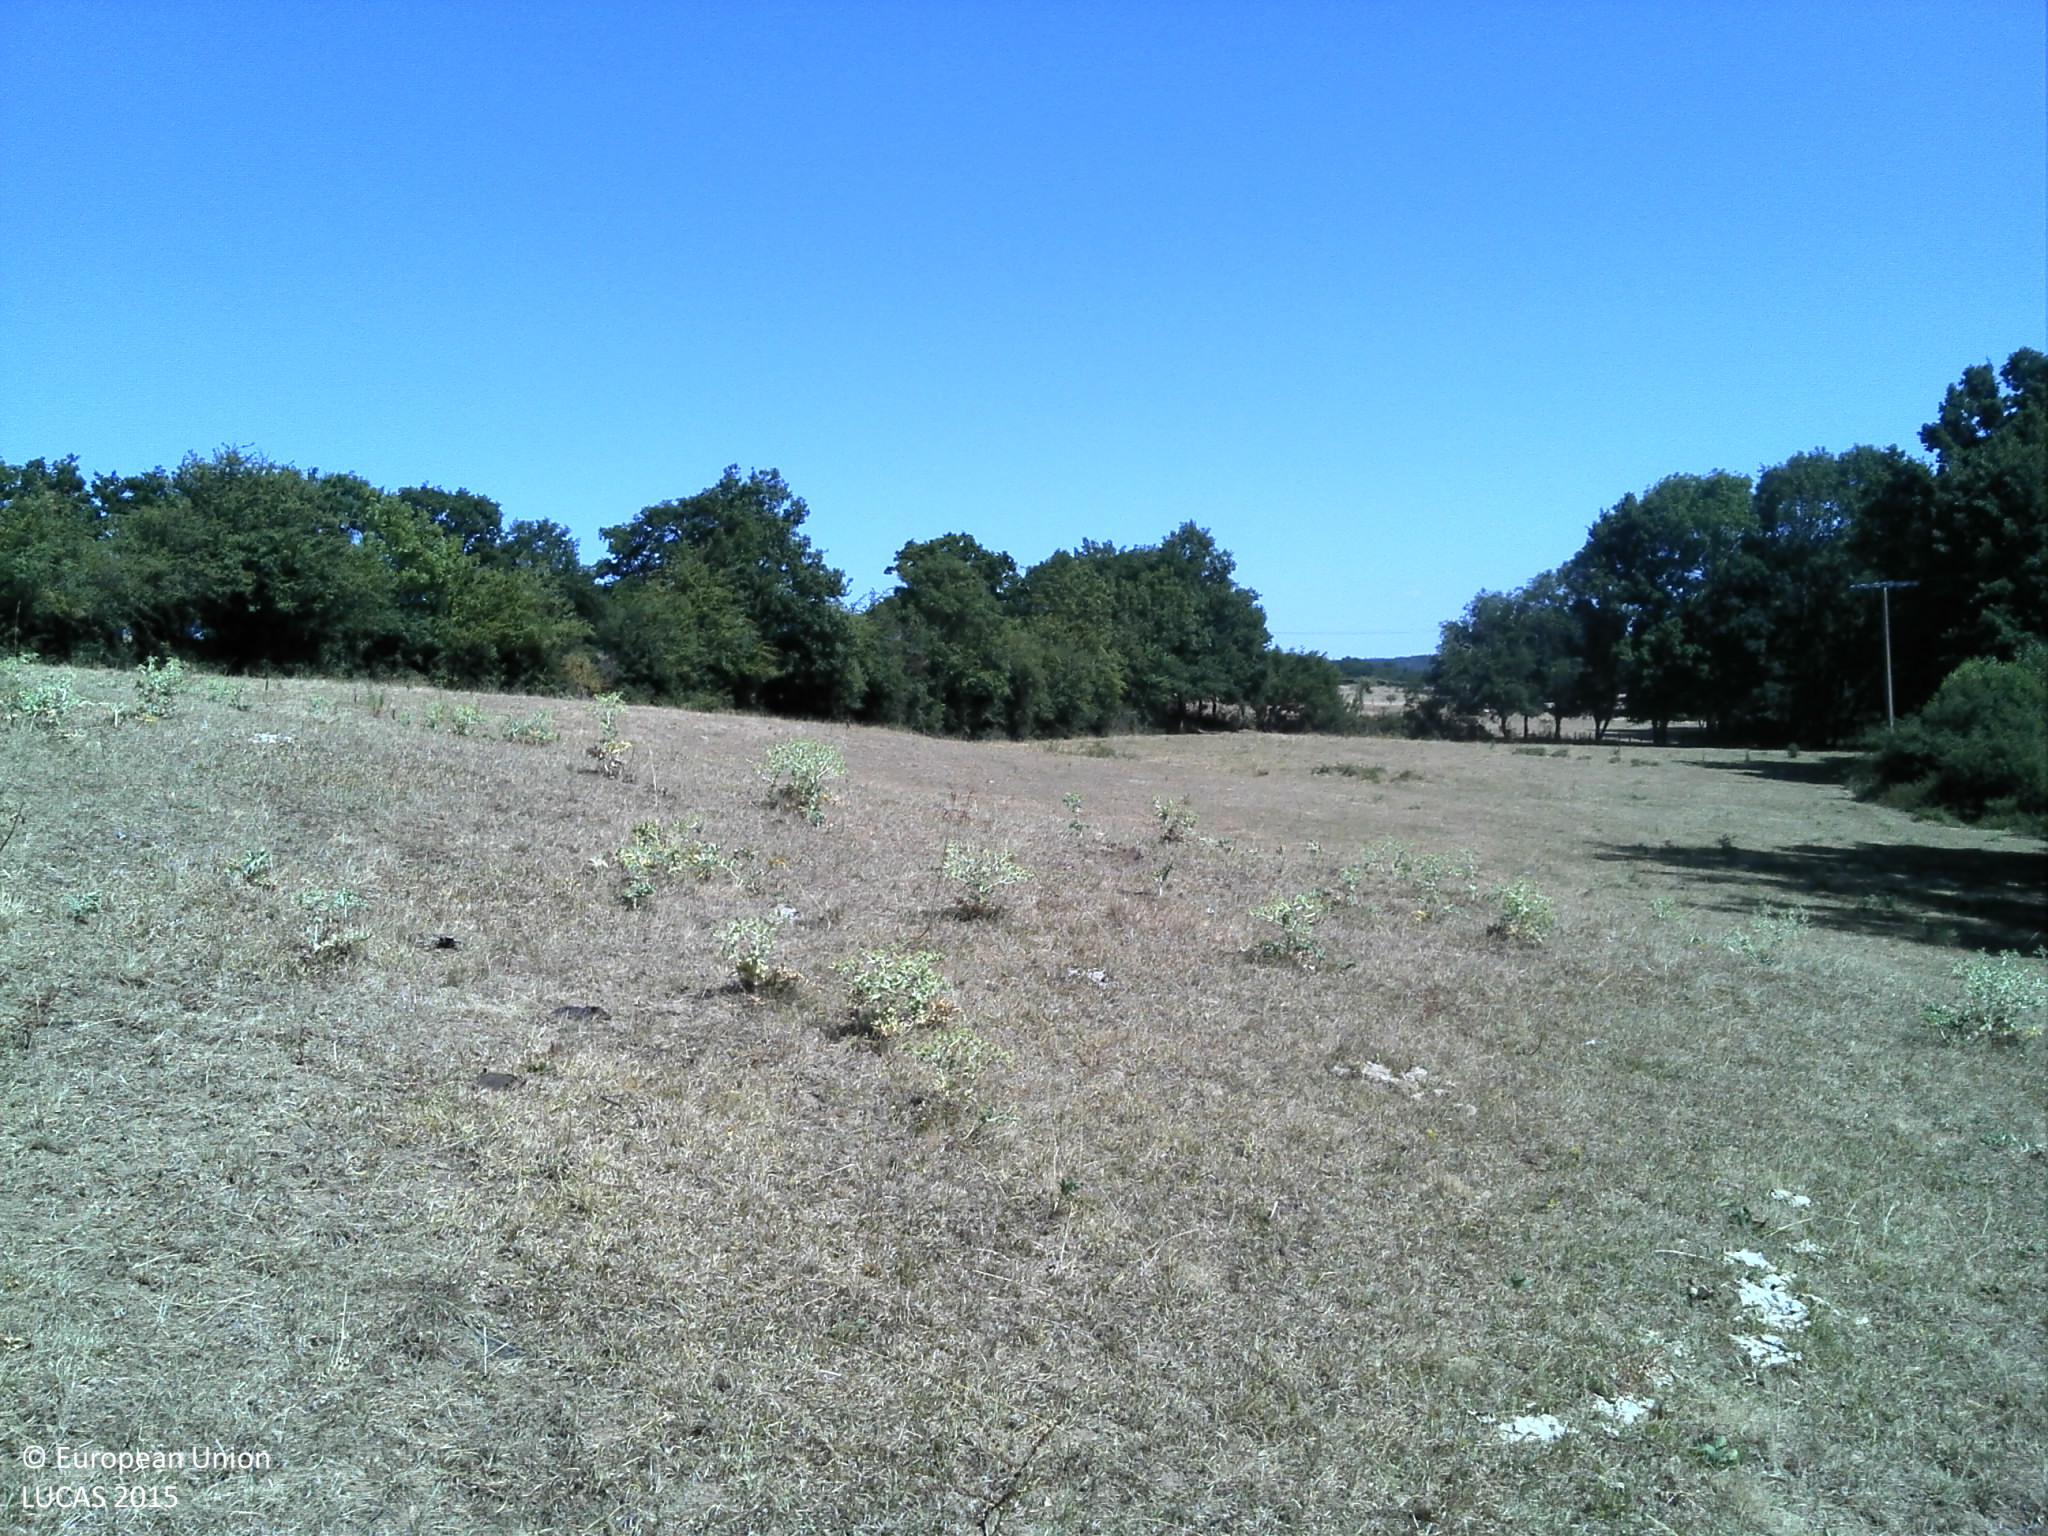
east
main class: Grassland
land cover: Grassland without tree/shrub cover
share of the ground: > 75 %
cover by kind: herbaceous plants 100 %
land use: Agriculture (excluding fallow land and kitchen gardens)
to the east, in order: Grassland without tree/shrub cover; Managed hedges; Fences; Grassland without tree/shrub cover; Fences; Abandoned hedges; Lines of trees; Fences; Grassland without tree/shrub cover; Fences; Grass margins; Barley
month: July
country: FR
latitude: 45.8792
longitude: 4.0623
